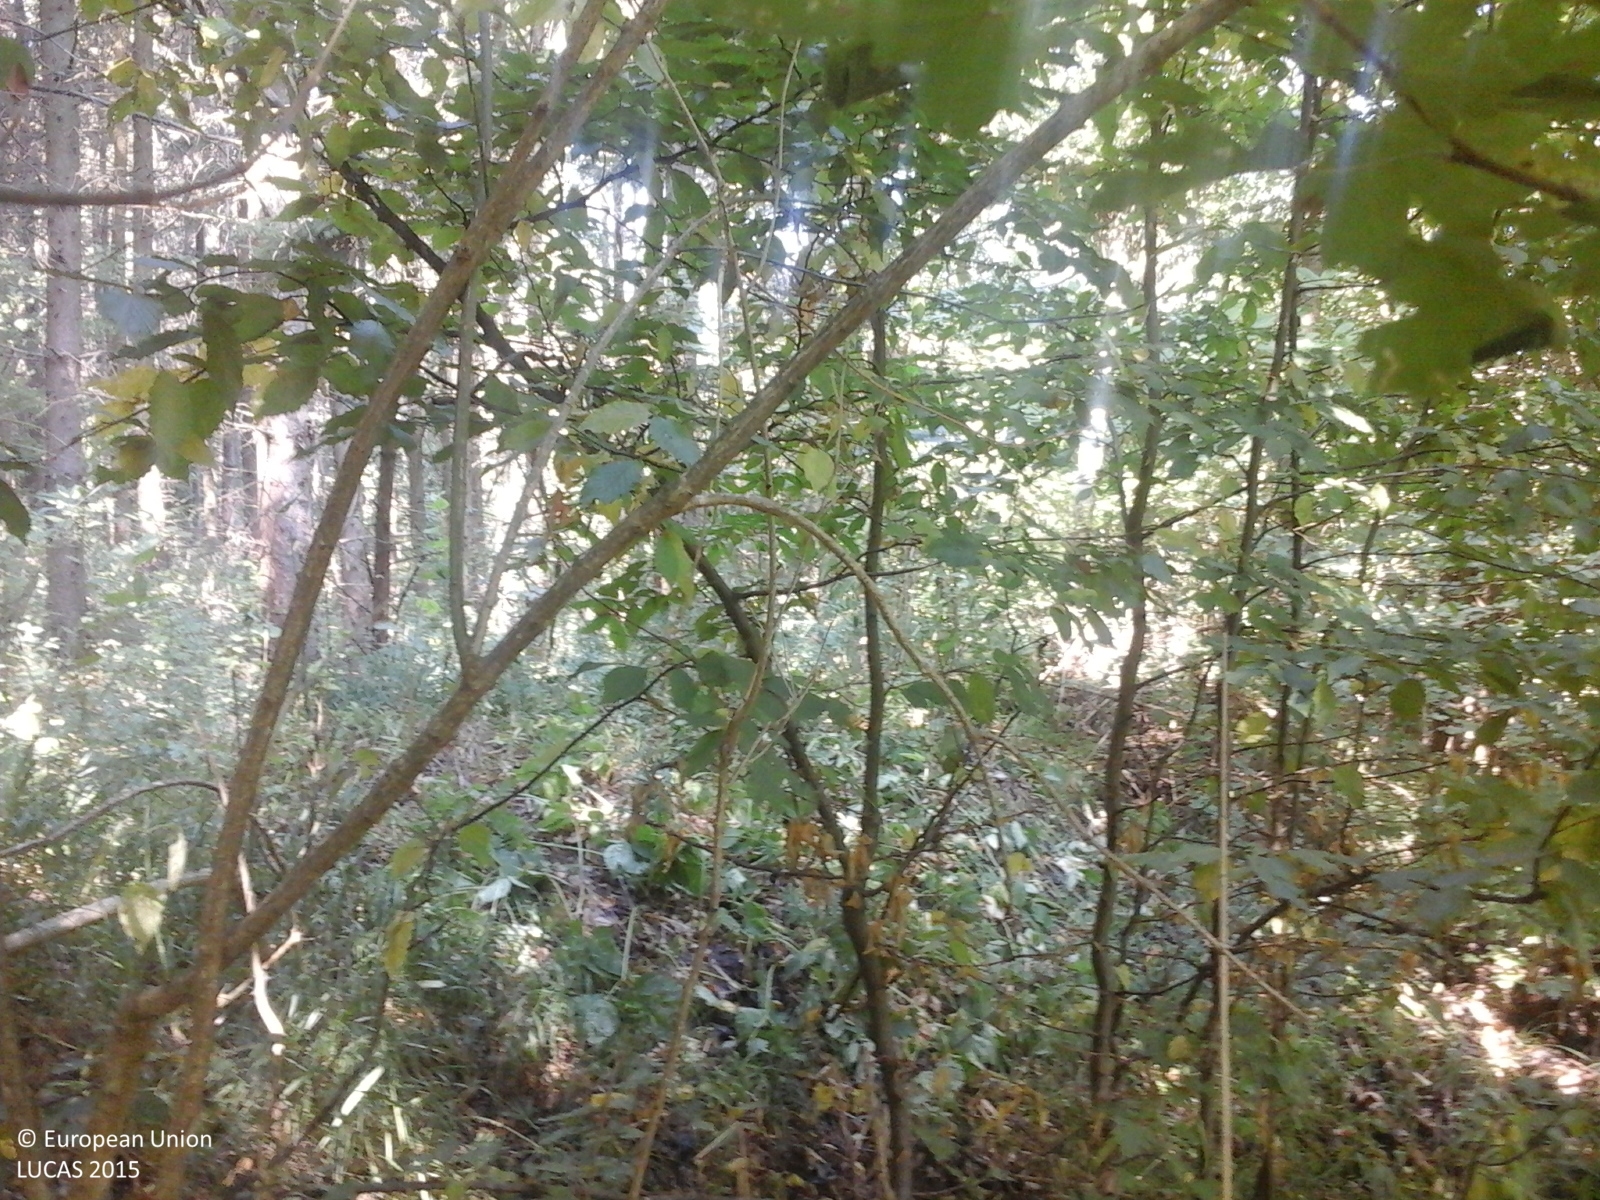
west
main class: Woodland
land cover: Spruce dominated coniferous woodland
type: alpine coniferous forest
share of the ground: > 75 %
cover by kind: coniferous forest trees 75 %, broadleaved forest trees 25 %
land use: Forestry
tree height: > 5 m
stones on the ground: 10 - 25 %
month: July
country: RO
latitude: 46.6110
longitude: 27.2476
